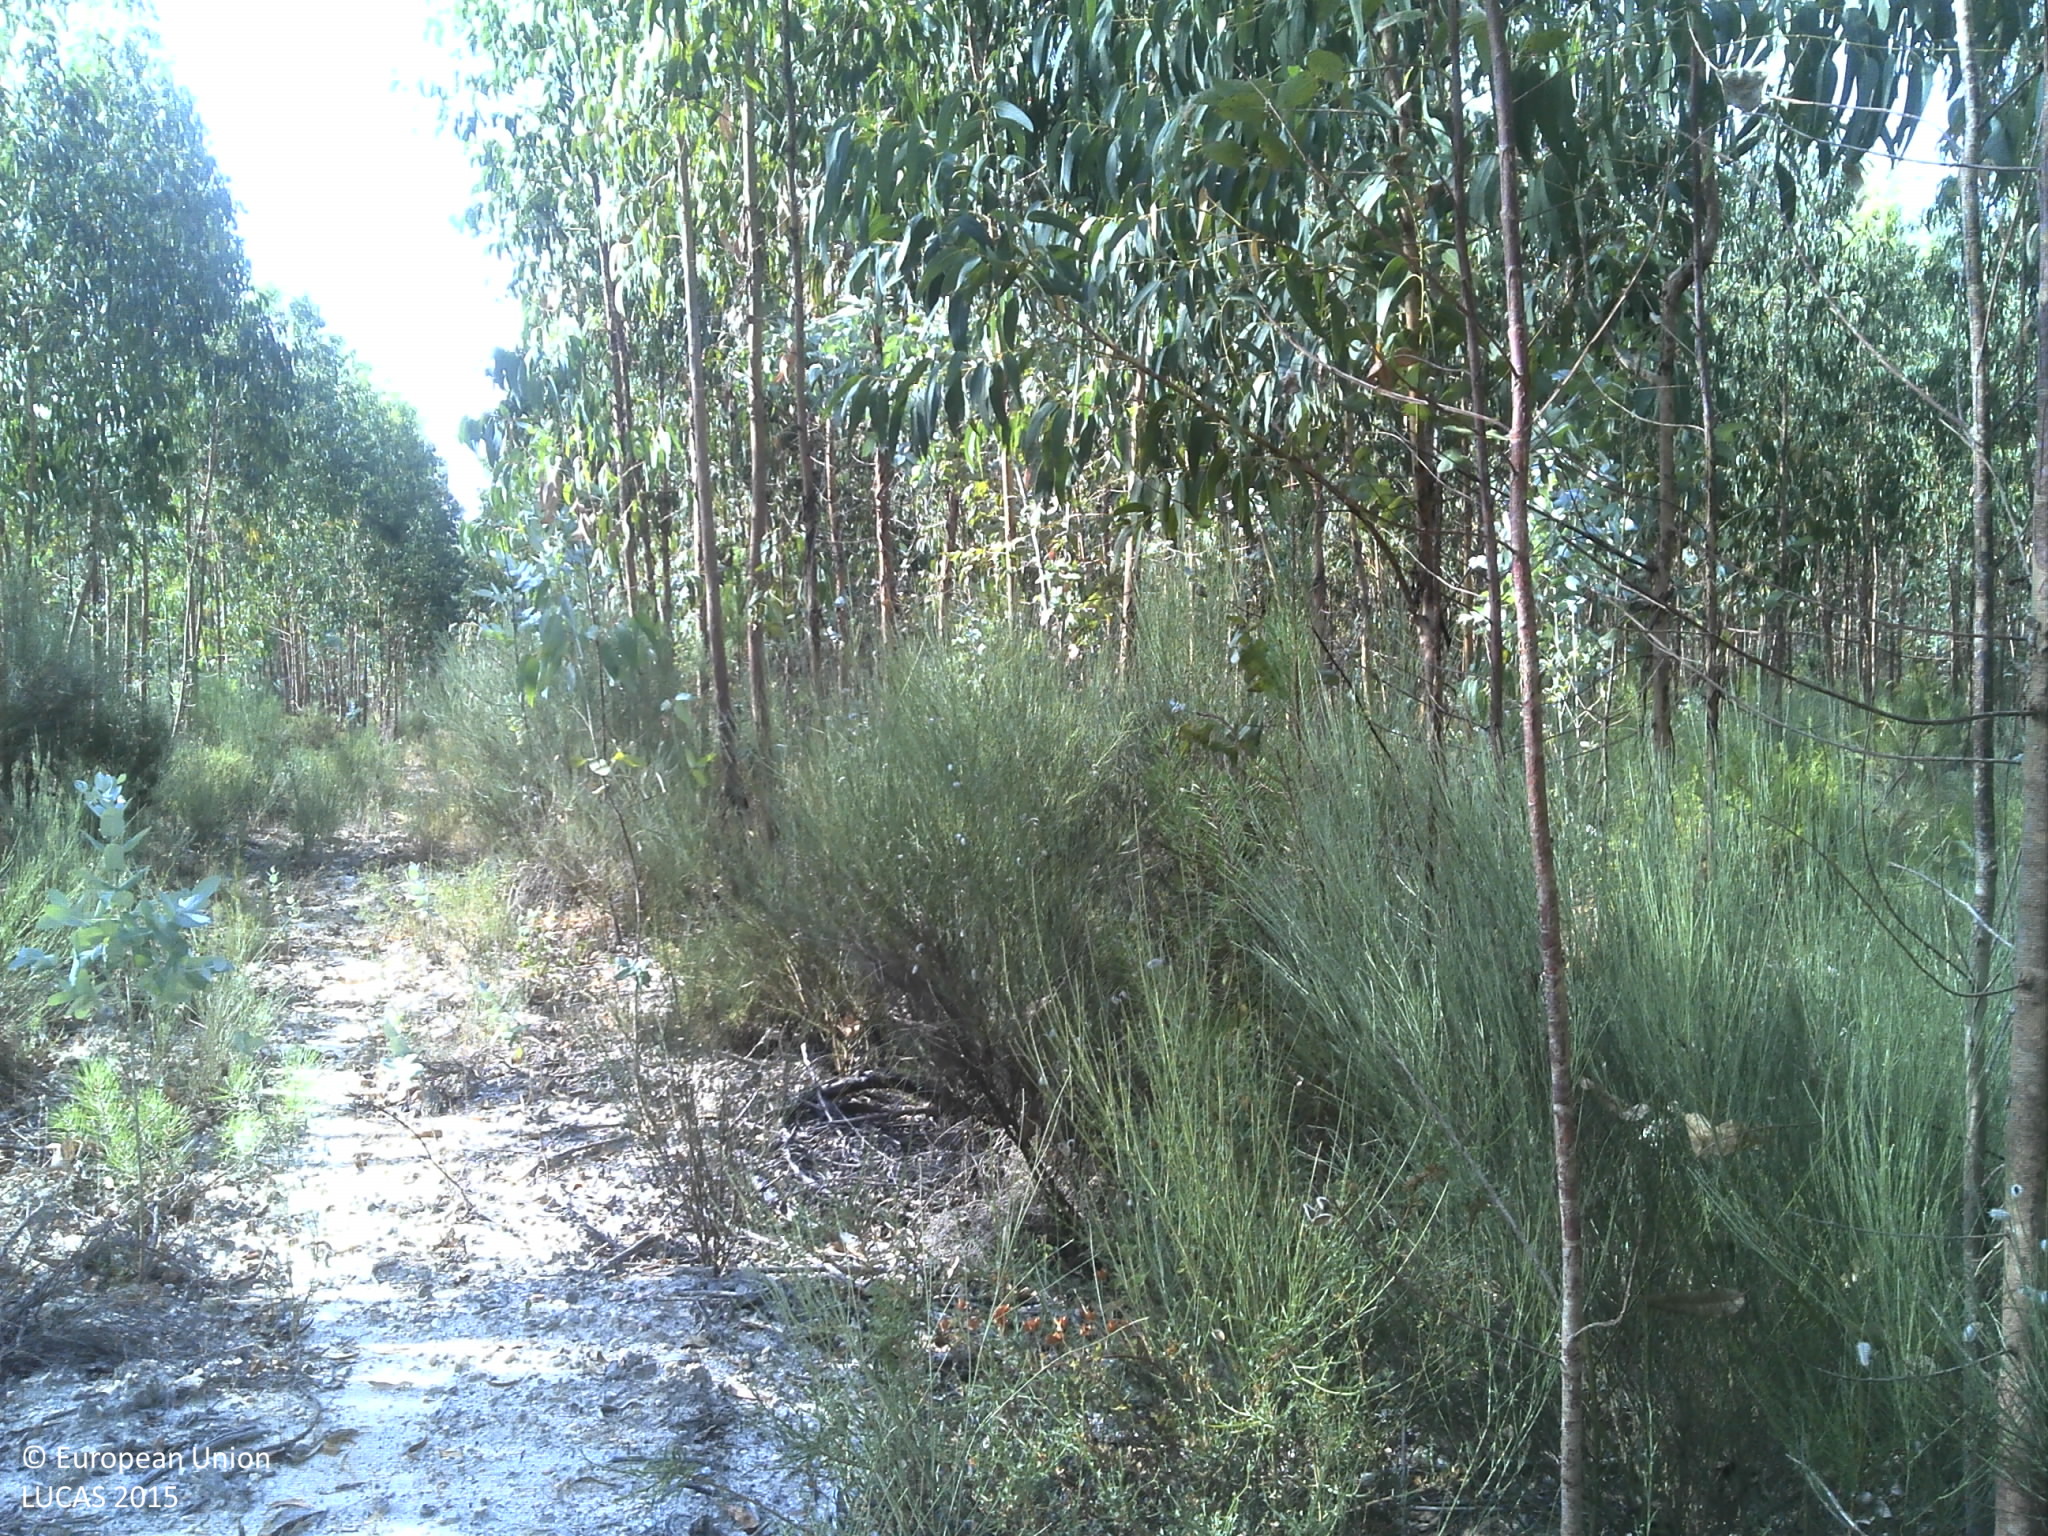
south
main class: Woodland
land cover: Broadleaved woodland
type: exotic forest
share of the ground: 50 - 75 %
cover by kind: broadleaved forest trees 60 %, unconsolidated bare surface 30 %, shrubs 10 %
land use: Forestry
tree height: > 5 m
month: July
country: PT
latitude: 39.1564
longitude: -8.3102
